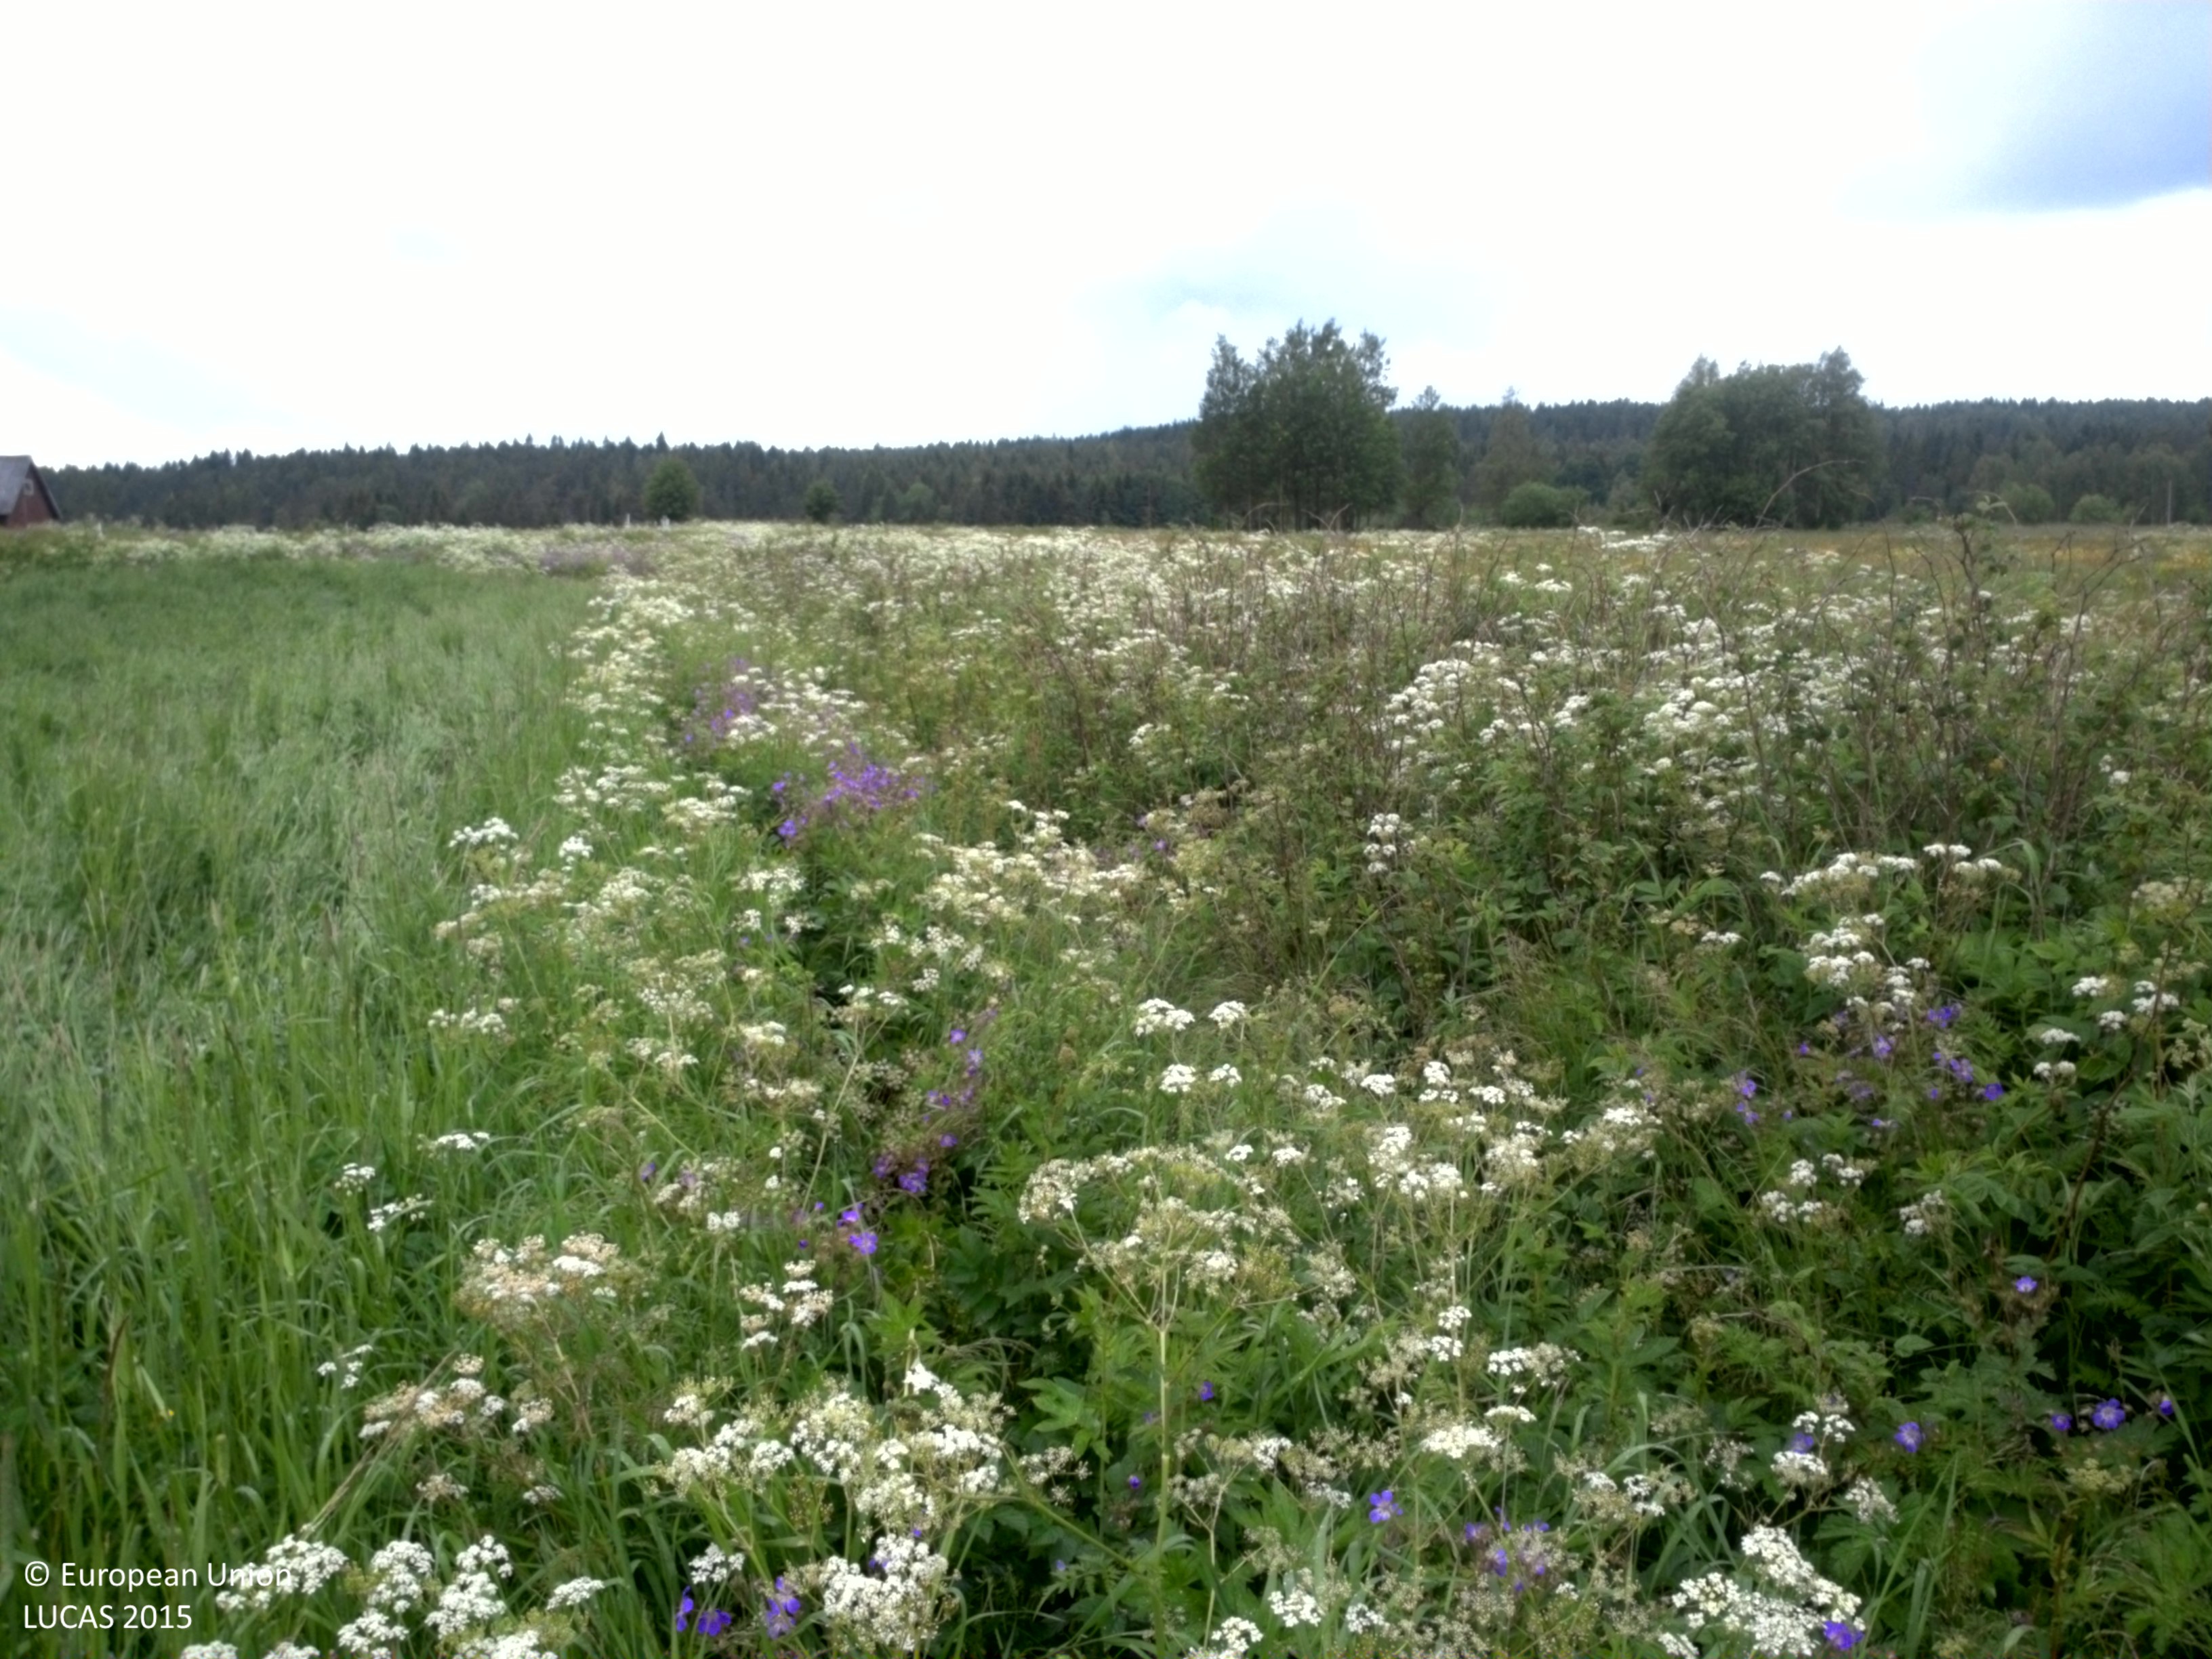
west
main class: Cropland
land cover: Other leguminous and mixtures for fodder
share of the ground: > 75 %
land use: Agriculture (excluding fallow land and kitchen gardens)
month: June
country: SE
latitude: 59.7501
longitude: 12.1474
